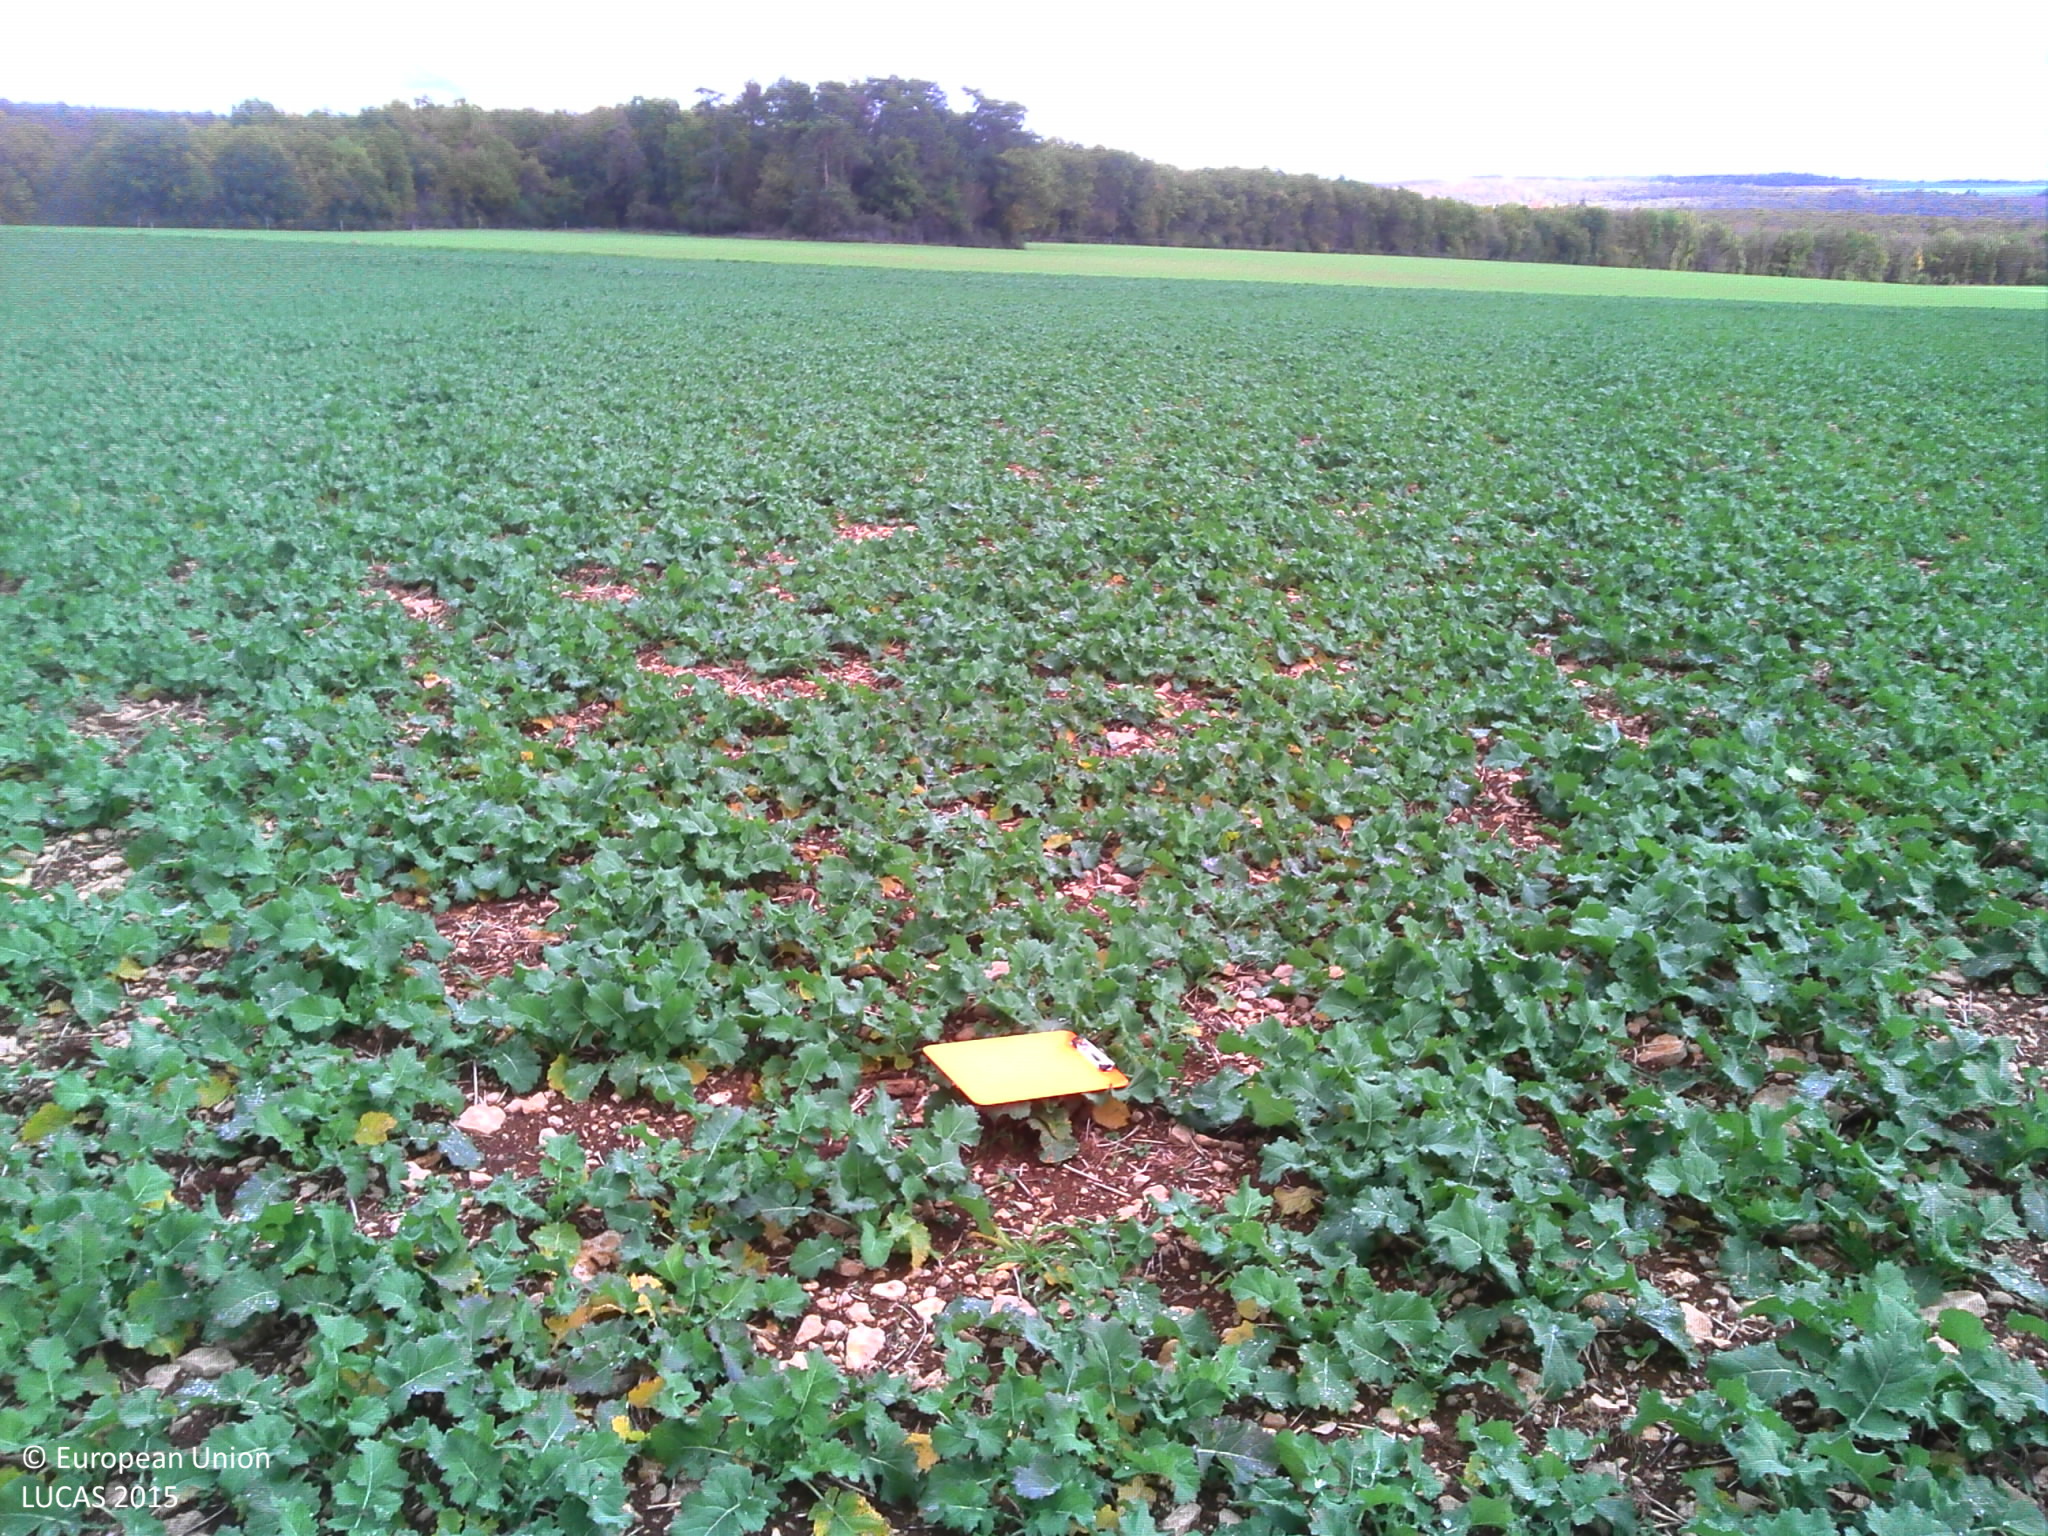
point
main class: Cropland
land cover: Rape and turnip rape
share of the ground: > 75 %
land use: Agriculture (excluding fallow land and kitchen gardens)
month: October
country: FR
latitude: 47.4189
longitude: 4.8704
